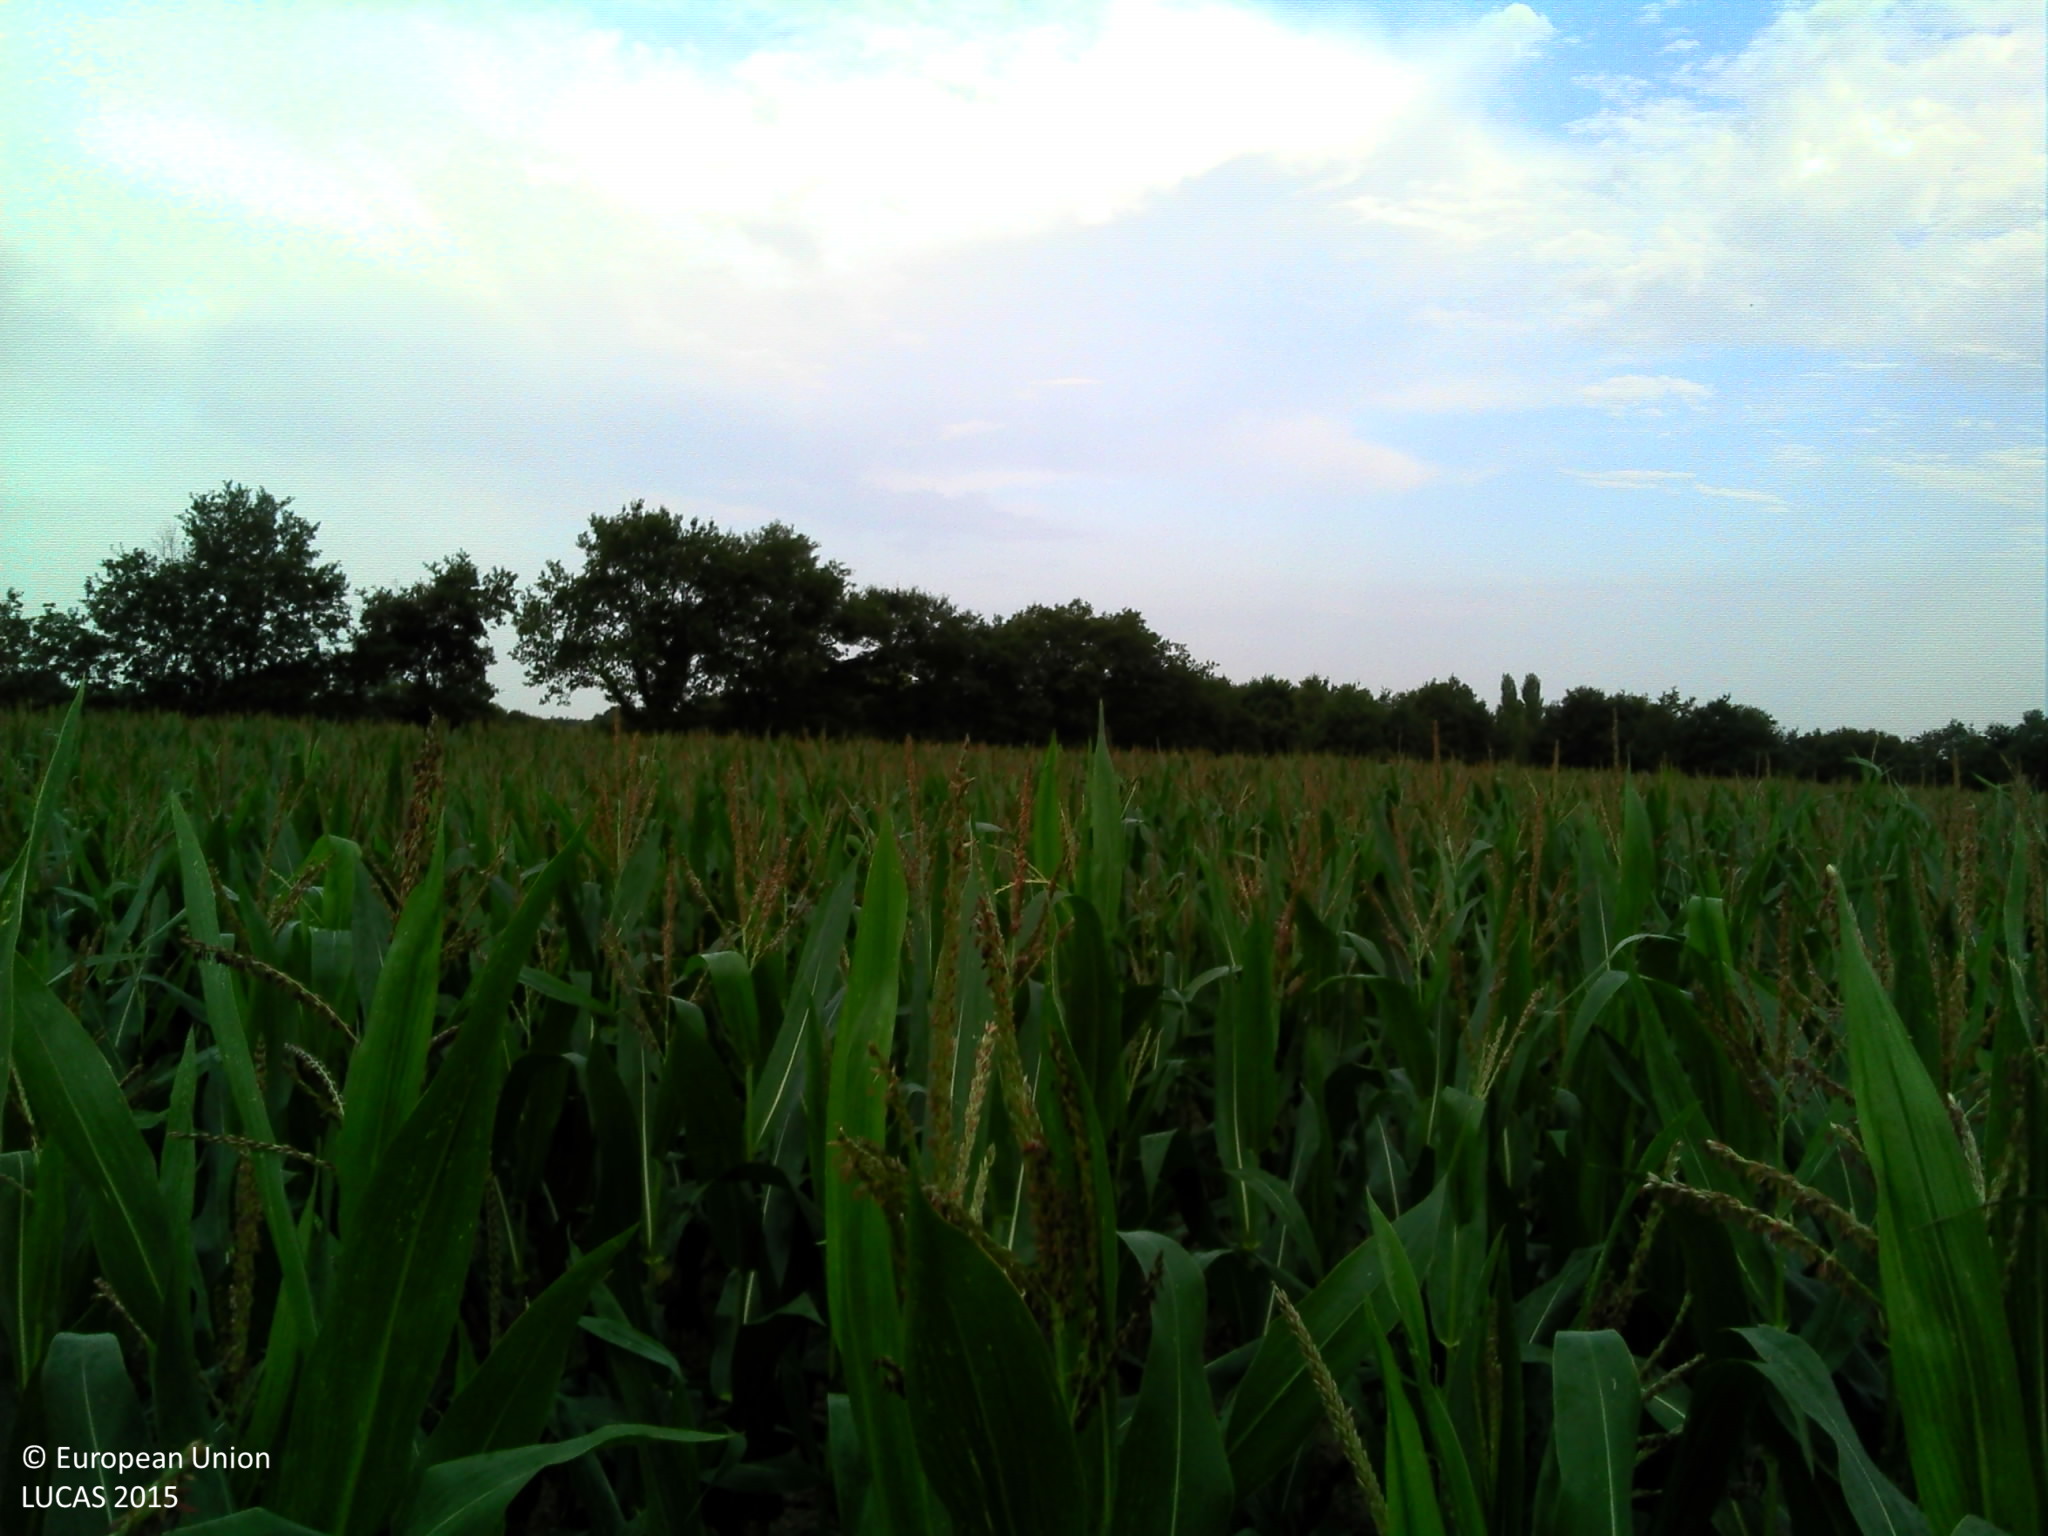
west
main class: Cropland
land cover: Maize
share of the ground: > 75 %
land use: Agriculture (excluding fallow land and kitchen gardens)
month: August
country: FR
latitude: 46.9852
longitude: -1.6515
